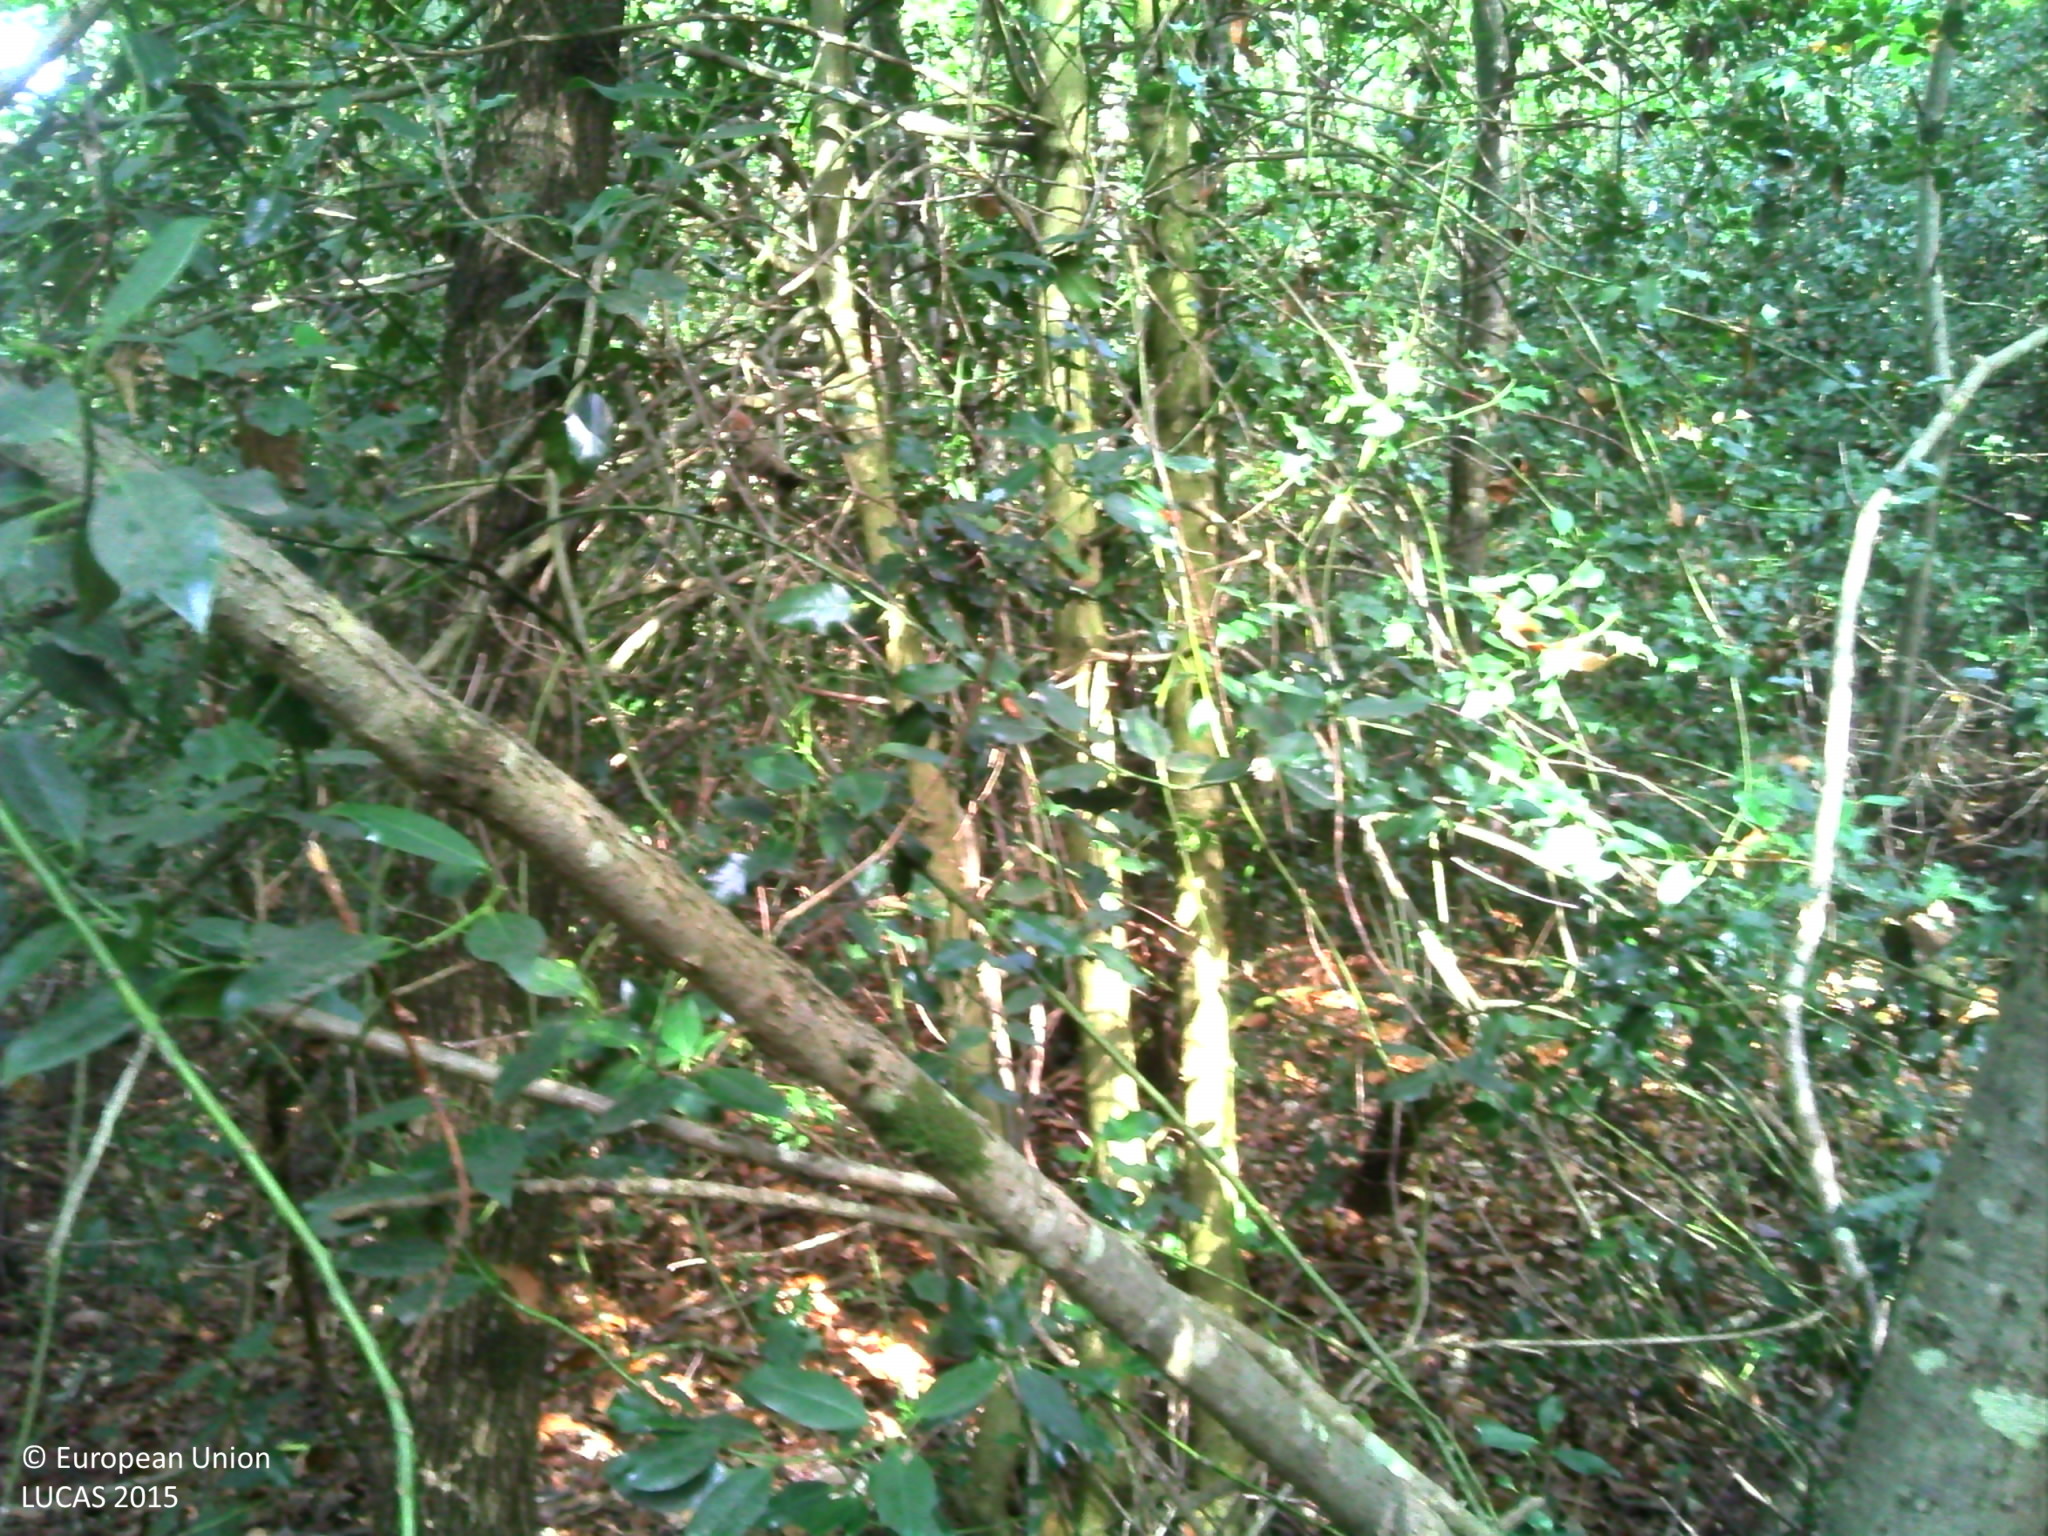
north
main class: Woodland
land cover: Broadleaved woodland
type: thermophilous deciduous forest
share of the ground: > 75 %
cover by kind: broadleaved forest trees 90 %, shrubs 5 %, unconsolidated bare surface 5 %
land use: Forestry
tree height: > 5 m
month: October
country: FR
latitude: 47.1480
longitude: -0.9671
